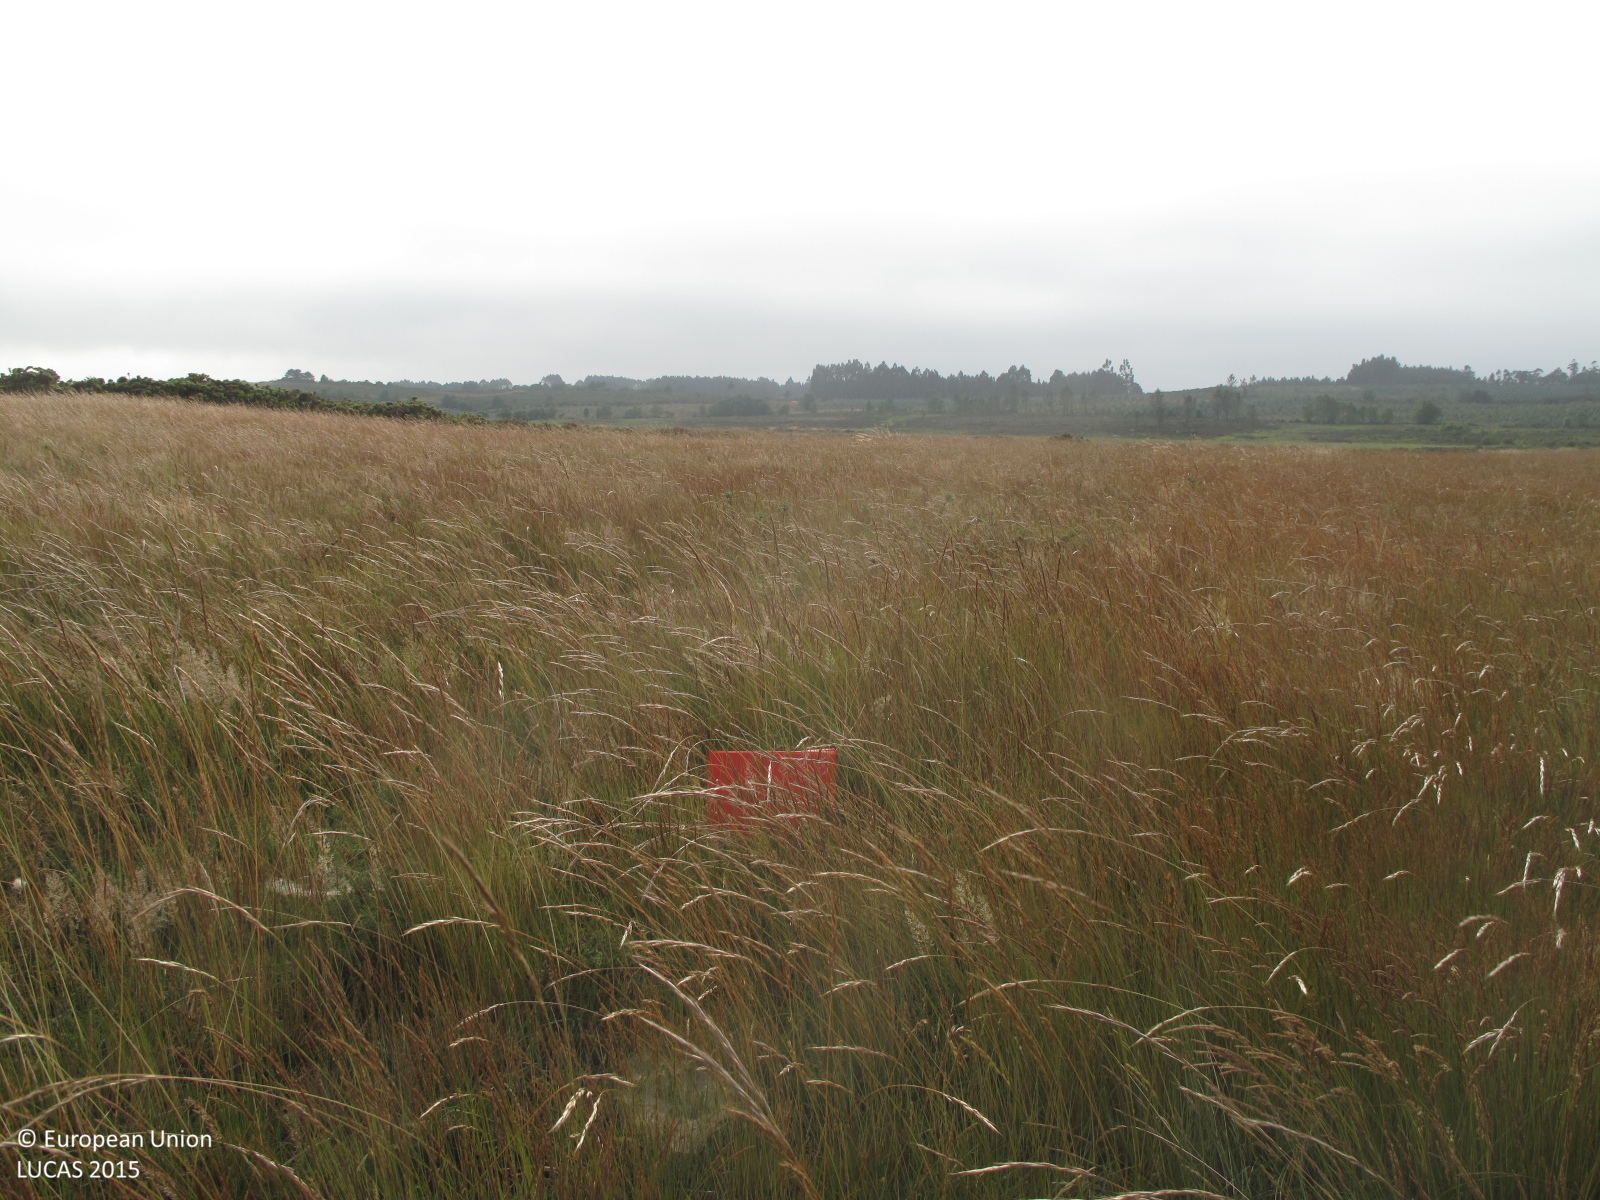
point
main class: Grassland
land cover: Grassland without tree/shrub cover
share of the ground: > 75 %
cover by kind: herbaceous plants 95 %, shrubs 5 %
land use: Semi-natural and natural areas not in use
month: June
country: ES
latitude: 43.1947
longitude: -8.0477
